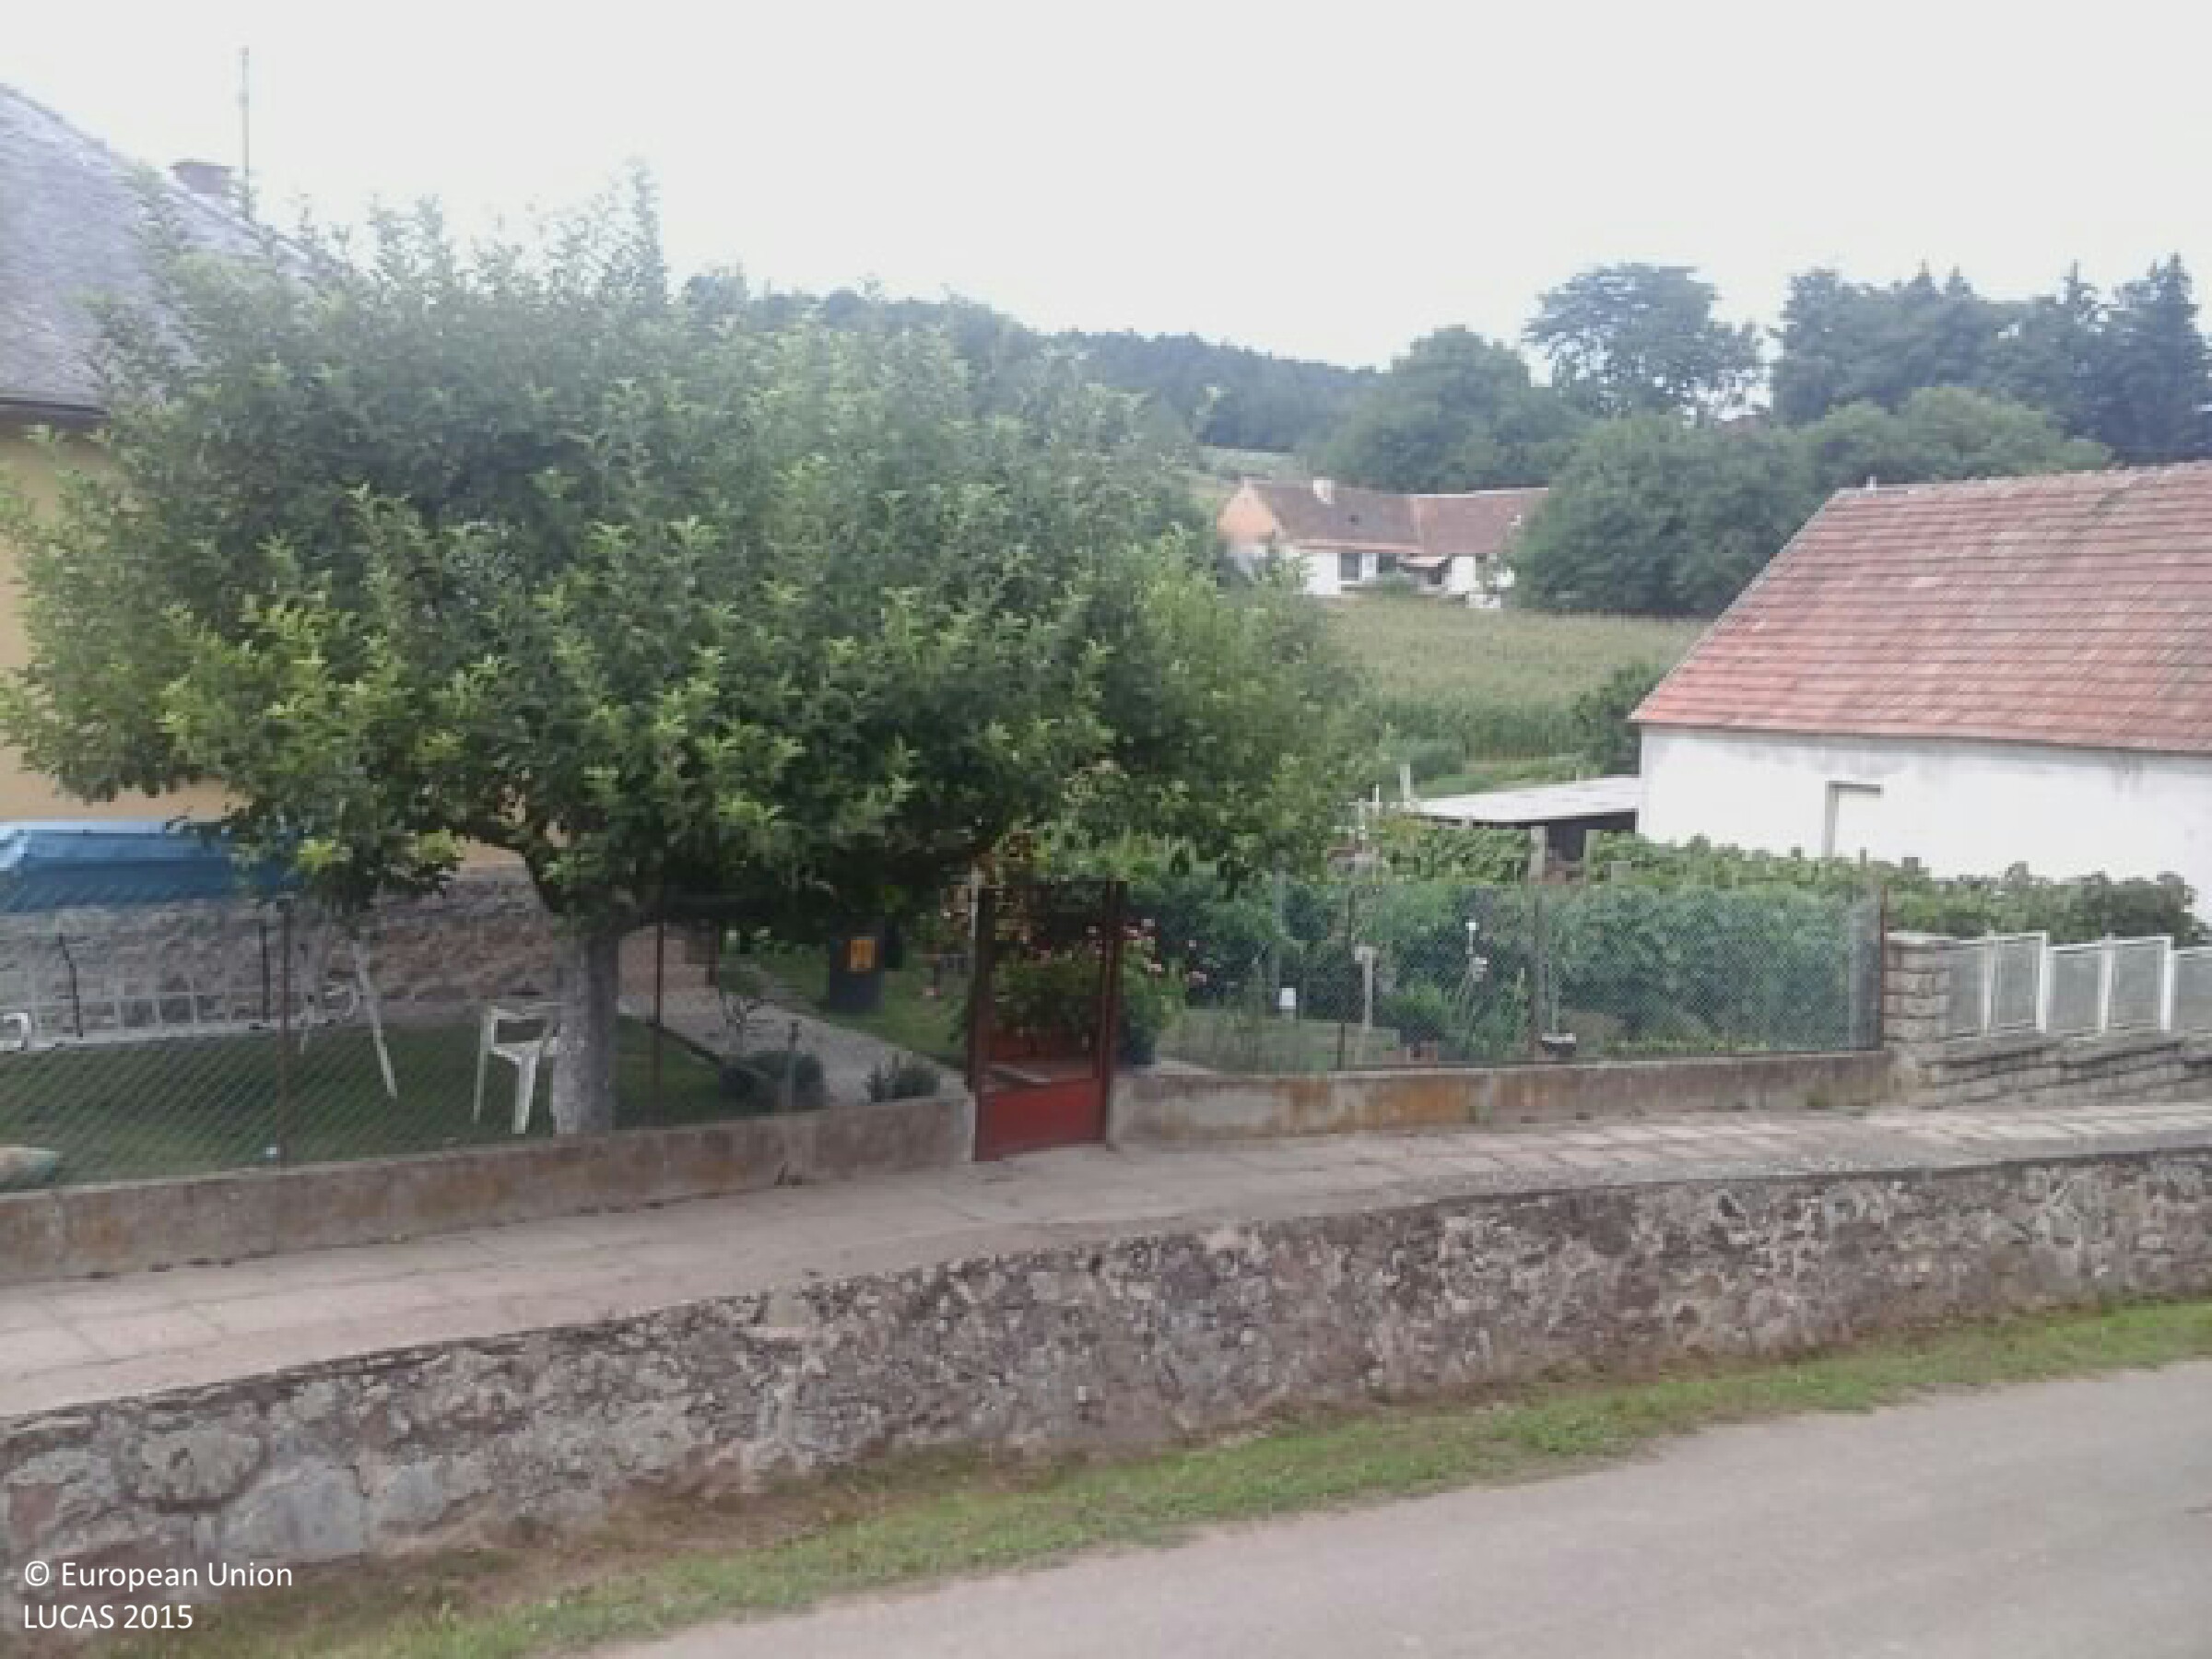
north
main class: Cropland
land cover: Floriculture and ornamental plants
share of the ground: > 75 %
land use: Kitchen garden
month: August
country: HU
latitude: 46.2359
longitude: 18.1901
